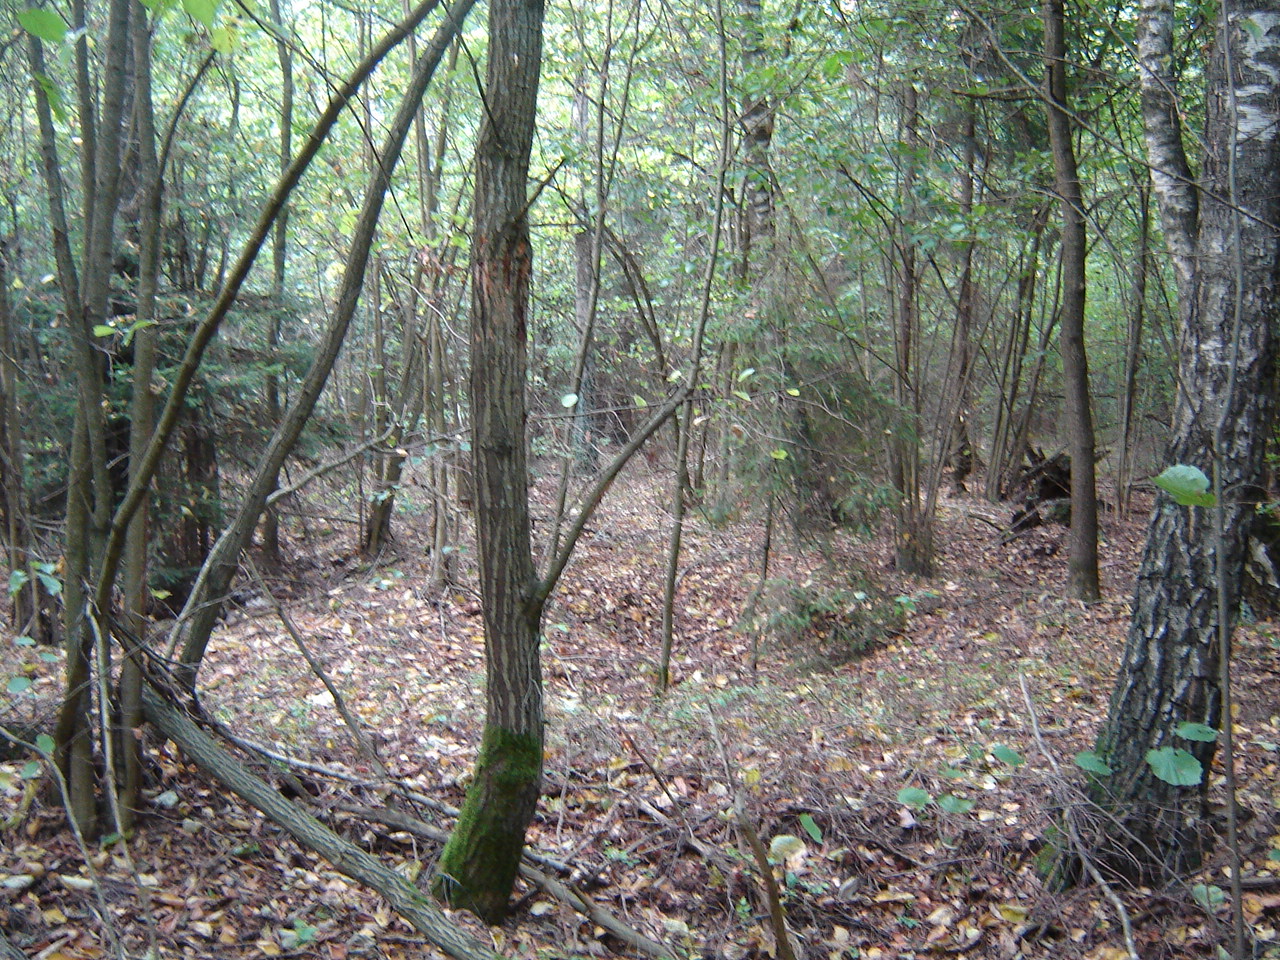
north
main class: Woodland
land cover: Pine dominated mixed woodland
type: hemiboreal forest and nemoral coniferous forest and mixed broadleaved-coniferous forest
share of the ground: > 75 %
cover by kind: broadleaved forest trees 50 %, coniferous forest trees 40 %, herbaceous plants 5 %, unconsolidated bare surface 5 %
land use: Forestry
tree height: > 5 m
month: September
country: LT
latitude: 54.1958
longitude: 25.0300
